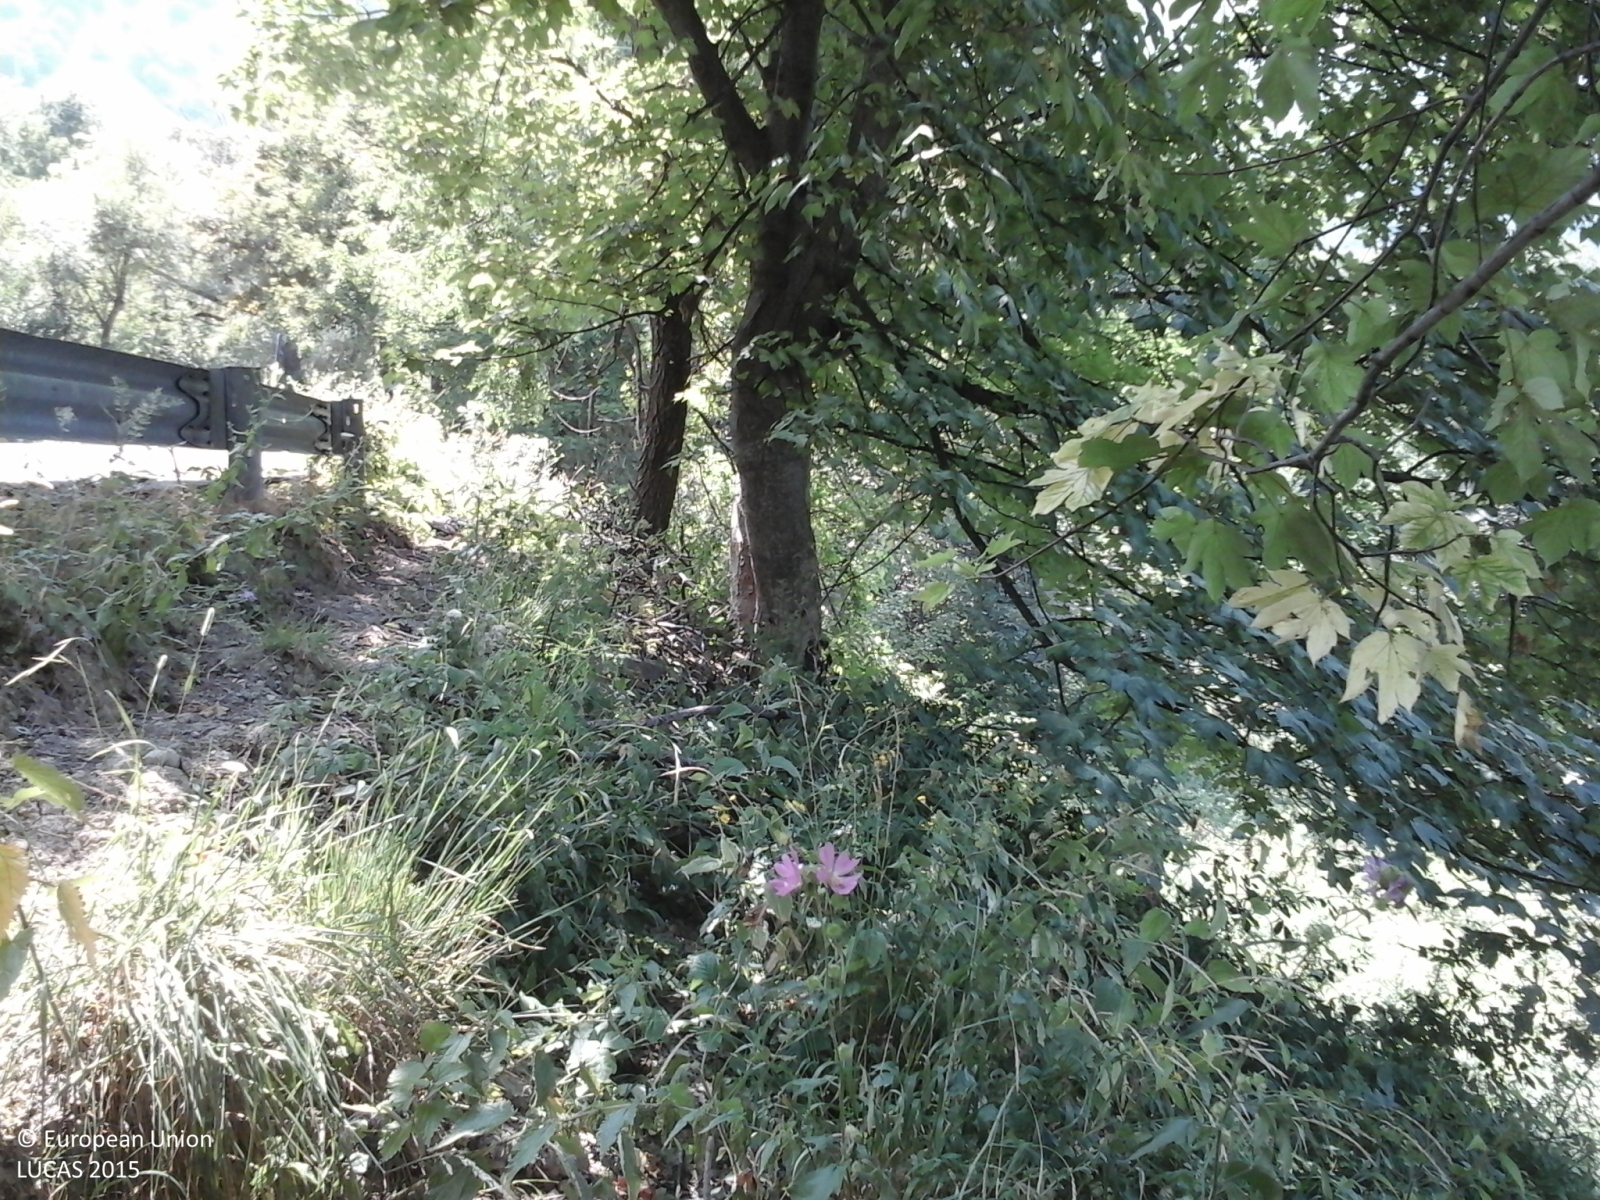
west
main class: Woodland
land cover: Broadleaved woodland
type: thermophilous deciduous forest
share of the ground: > 75 %
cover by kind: broadleaved forest trees 70 %, shrubs 25 %, herbaceous plants 5 %
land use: Semi-natural and natural areas not in use
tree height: > 5 m
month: September
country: IT
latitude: 42.1043
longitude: 14.0138
